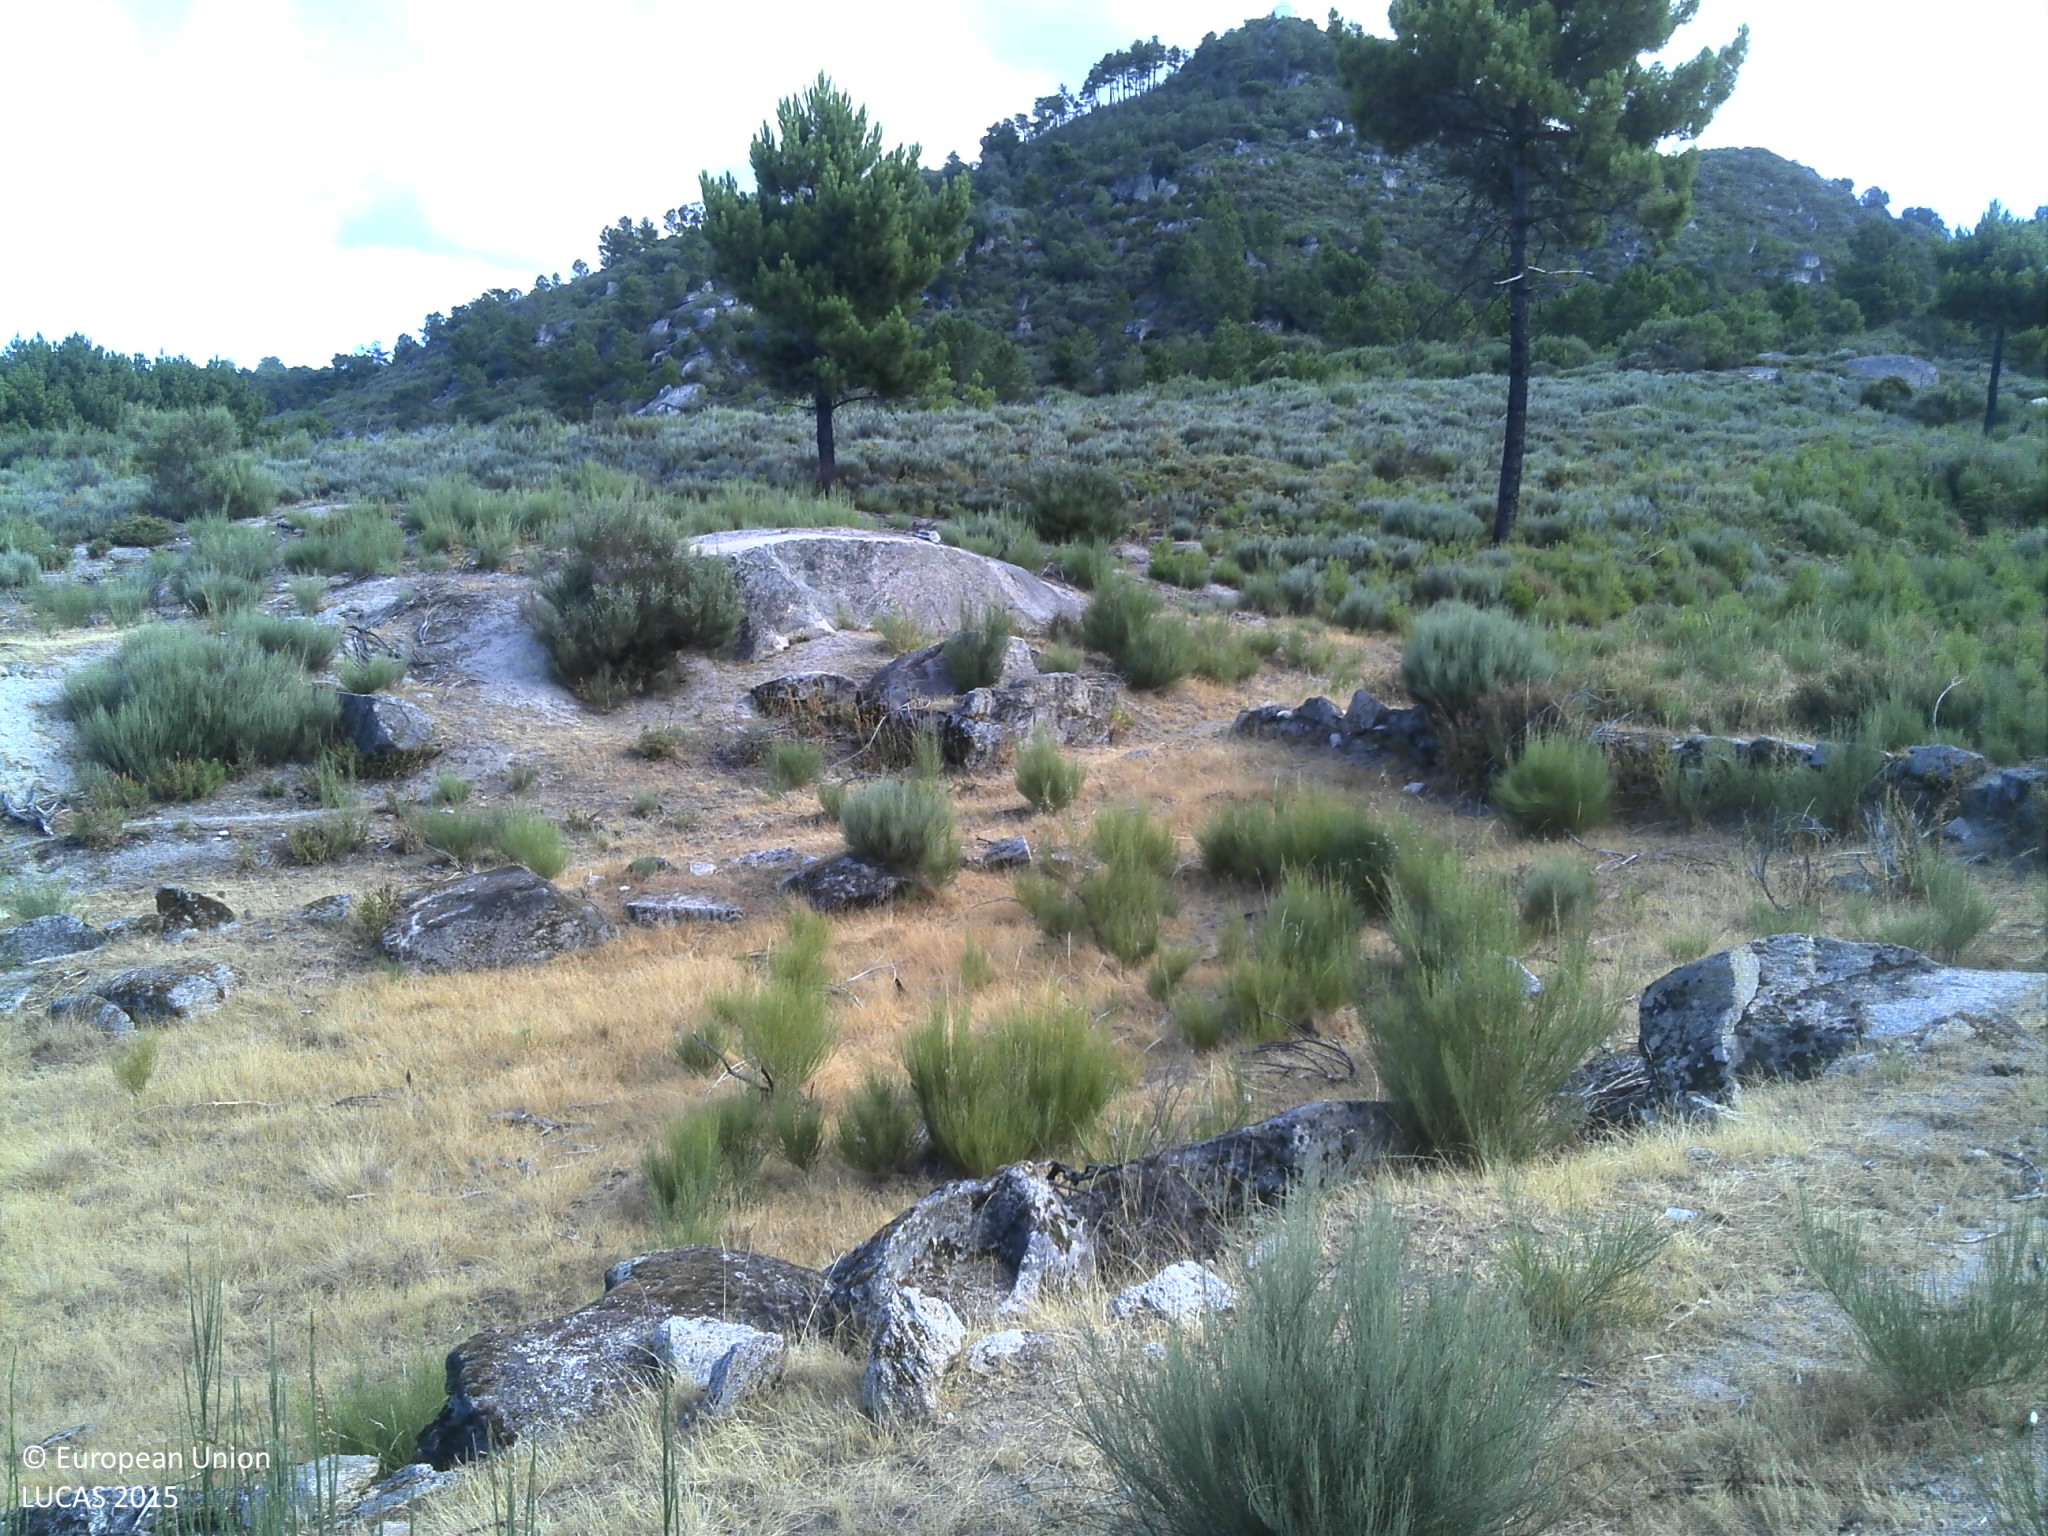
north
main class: Shrubland
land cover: Shrubland with sparse tree cover
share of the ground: 25 - 50 %
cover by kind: shrubs 45 %, herbaceous plants 25 %, consolidated bare surface 20 %, coniferous forest trees 5 %, unconsolidated bare surface 5 %
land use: Semi-natural and natural areas not in use
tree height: > 5 m
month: July
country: PT
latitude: 41.2780
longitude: -7.4210
